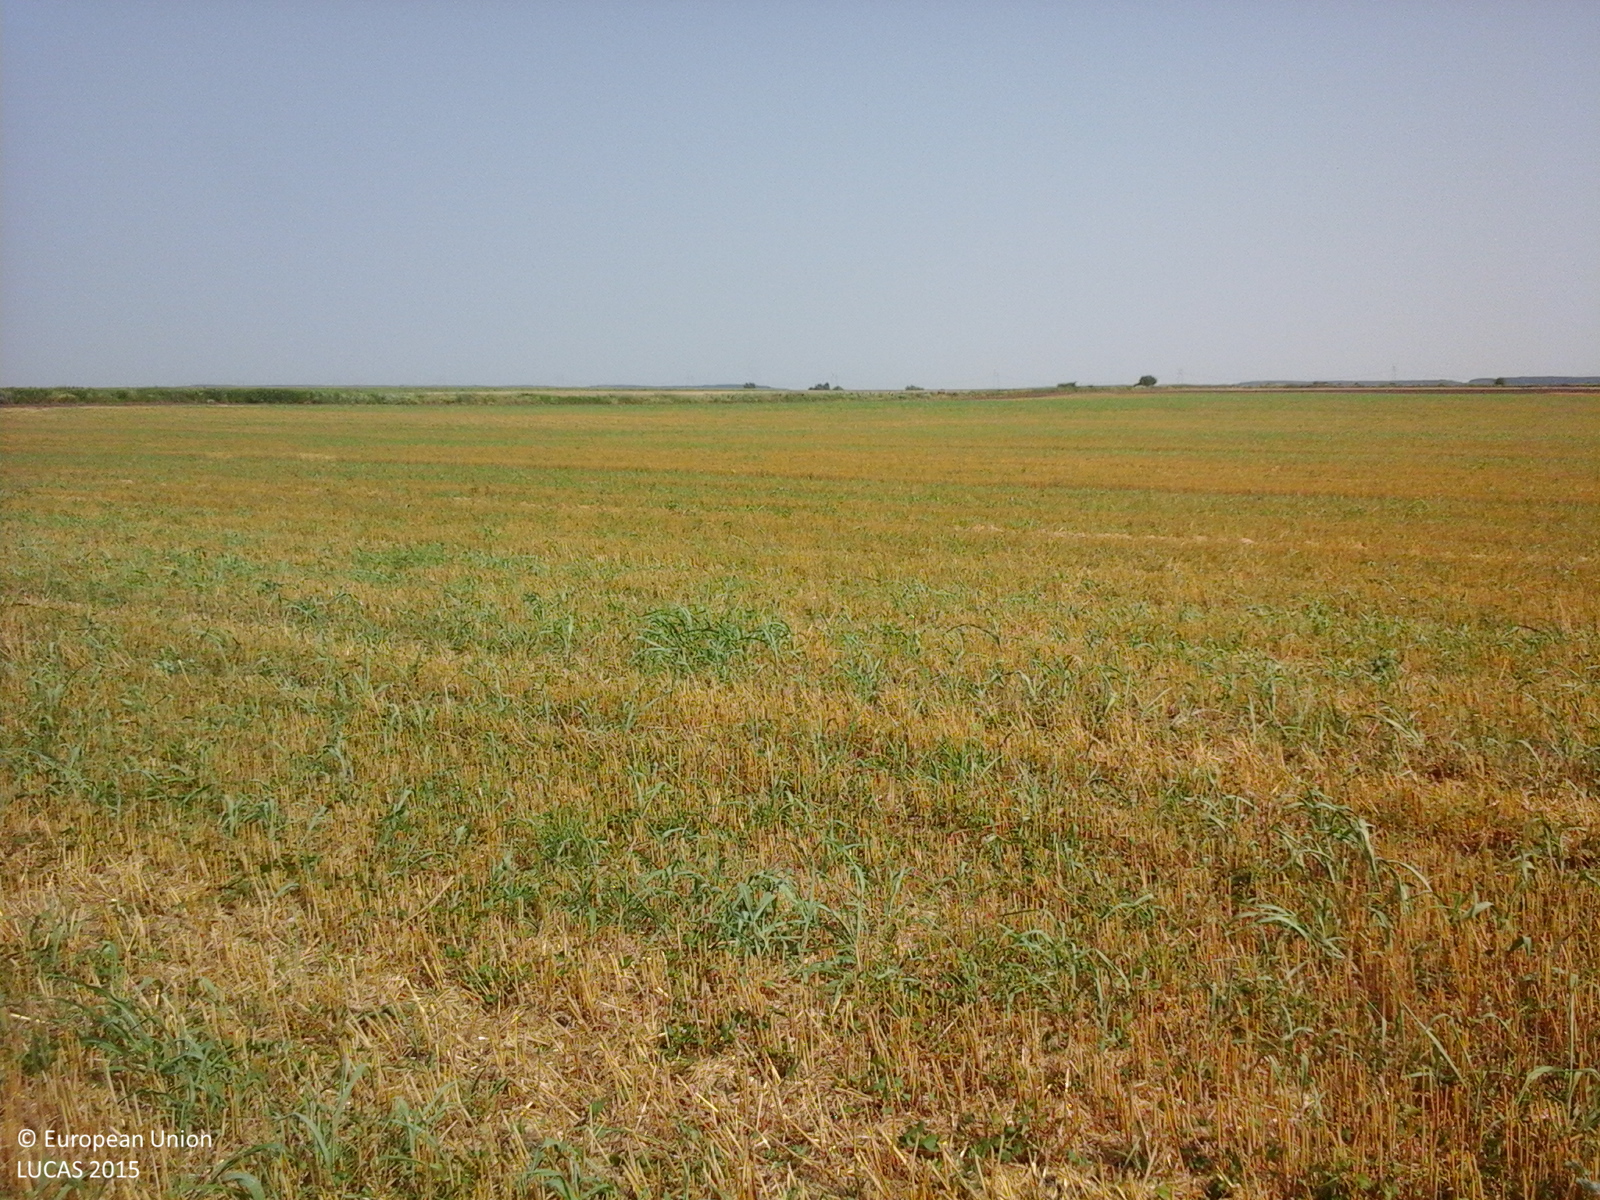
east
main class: Cropland
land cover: Durum wheat
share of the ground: 25 - 50 %
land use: Agriculture (excluding fallow land and kitchen gardens)
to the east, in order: Durum wheat; Inland marshes; Ditches and canals; Inland marshes; Rape and turnip rape
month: July
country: RO
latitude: 44.5375
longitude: 26.5406
